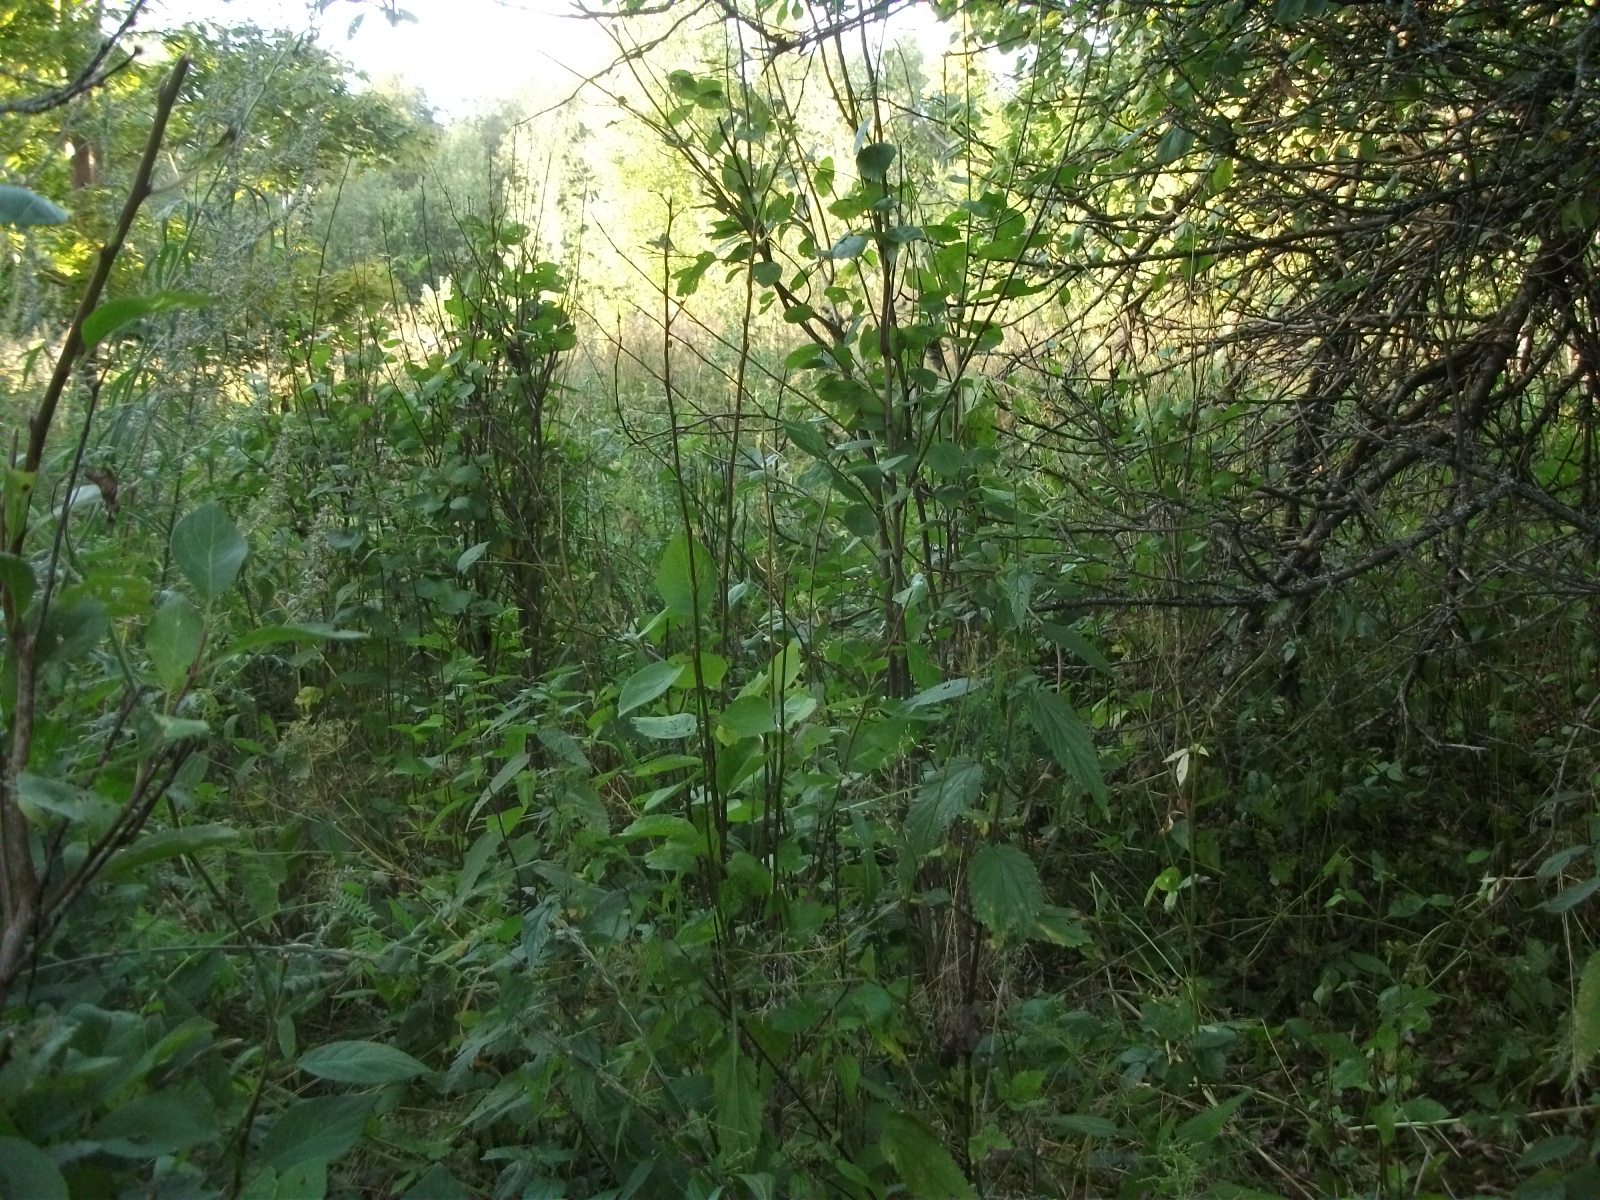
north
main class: Cropland
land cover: Other fruit trees and berries
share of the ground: 25 - 50 %
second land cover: Spontaneously vegetated surfaces
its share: > 75 %
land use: Abandoned areas
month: August
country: LV
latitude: 56.5129
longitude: 26.3119
